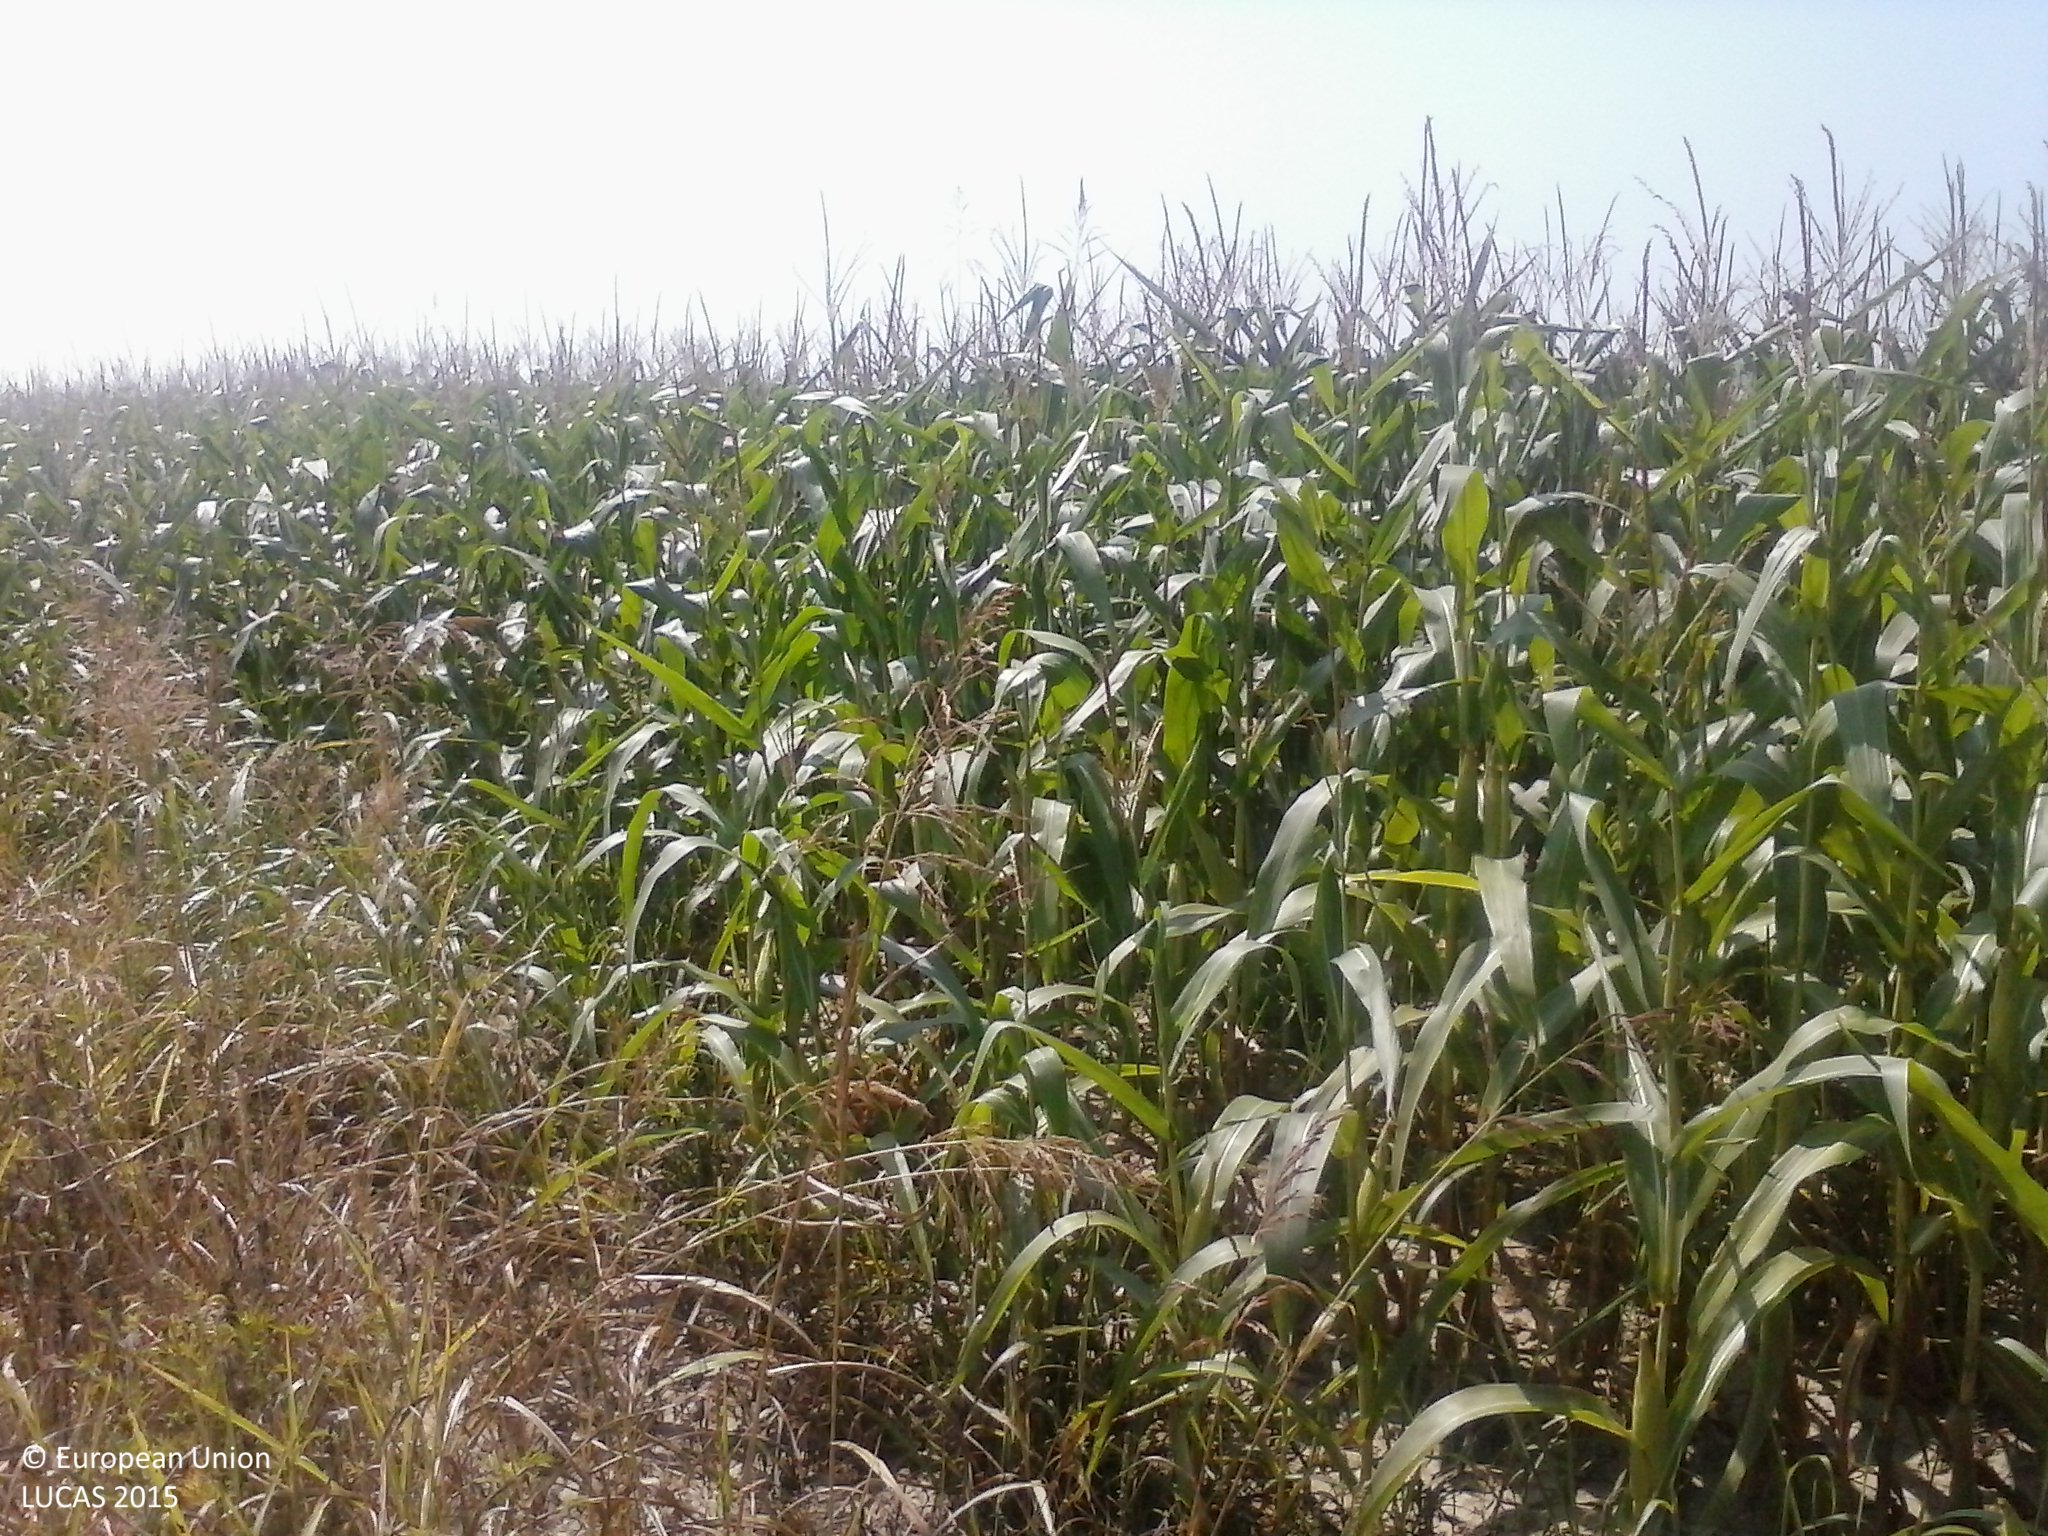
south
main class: Cropland
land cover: Maize
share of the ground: > 75 %
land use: Agriculture (excluding fallow land and kitchen gardens)
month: August
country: HU
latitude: 45.8785
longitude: 17.6439
